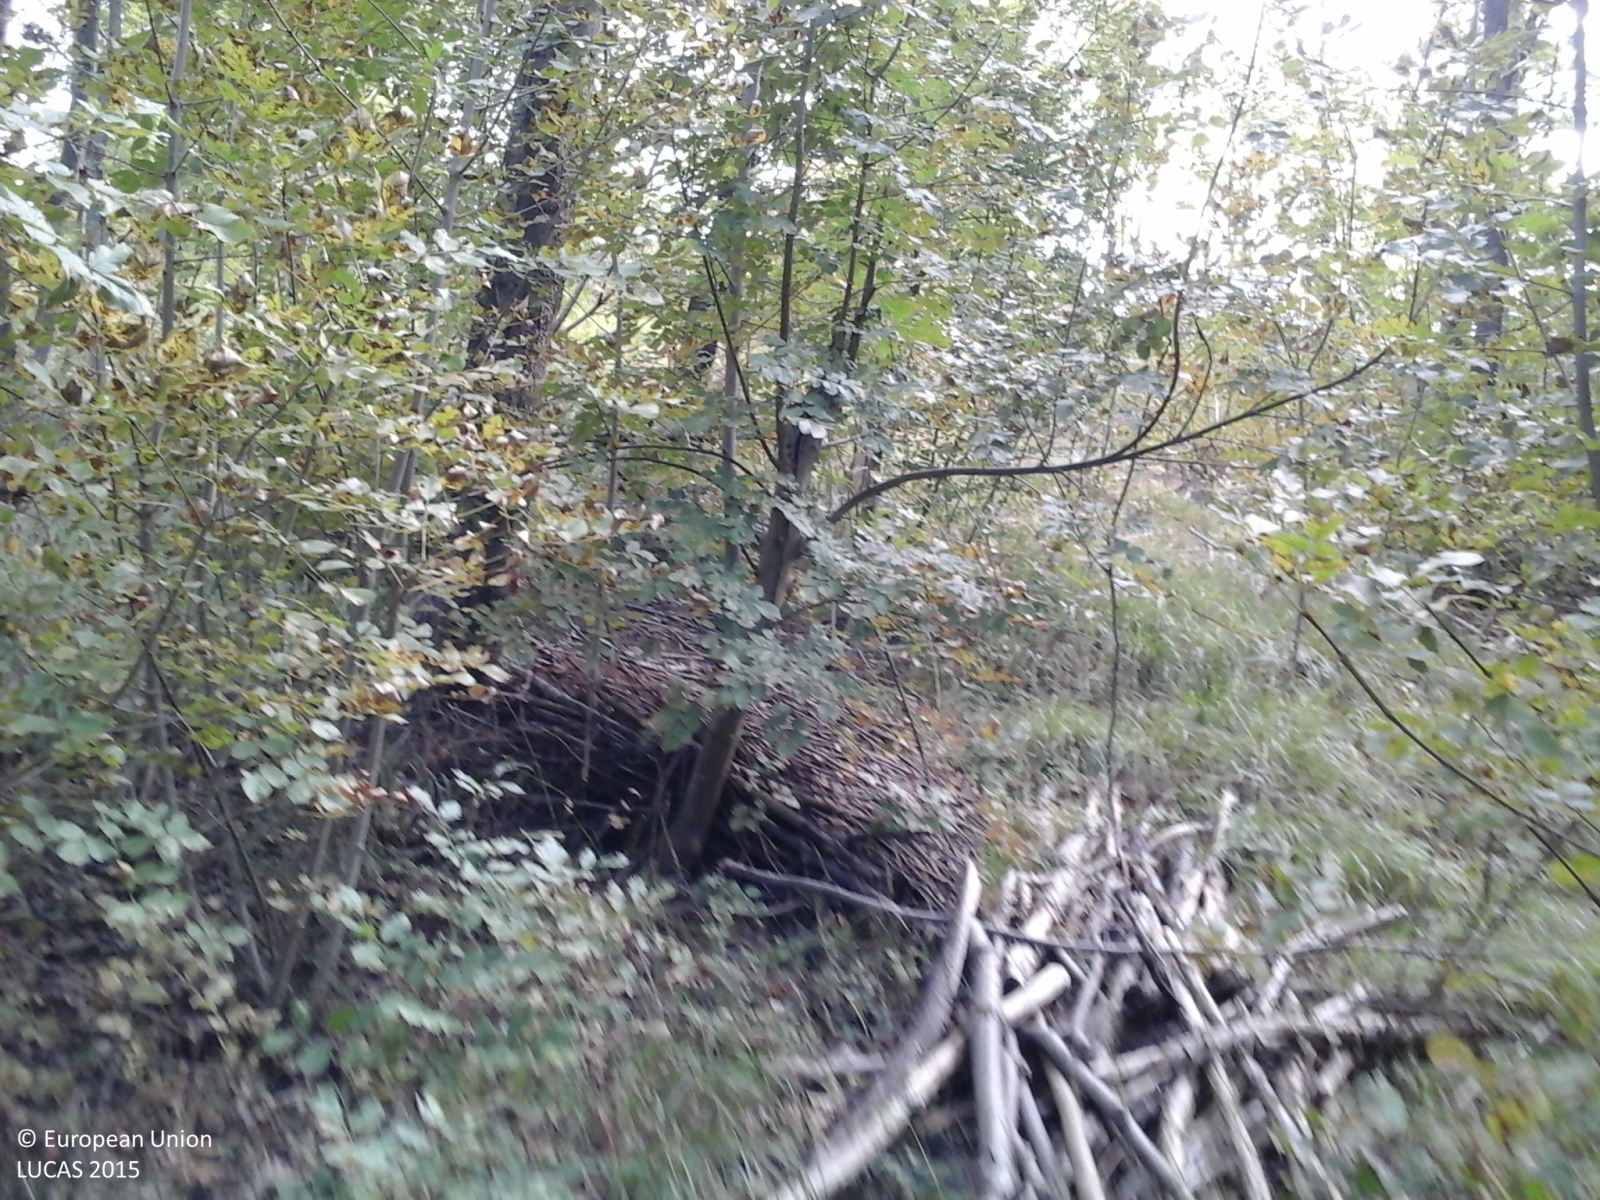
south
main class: Woodland
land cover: Broadleaved woodland
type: thermophilous deciduous forest
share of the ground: > 75 %
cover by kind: broadleaved forest trees 70 %, herbaceous plants 20 %, shrubs 10 %
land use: Forestry
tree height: > 5 m
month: September
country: IT
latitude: 44.4466
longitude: 8.4077
